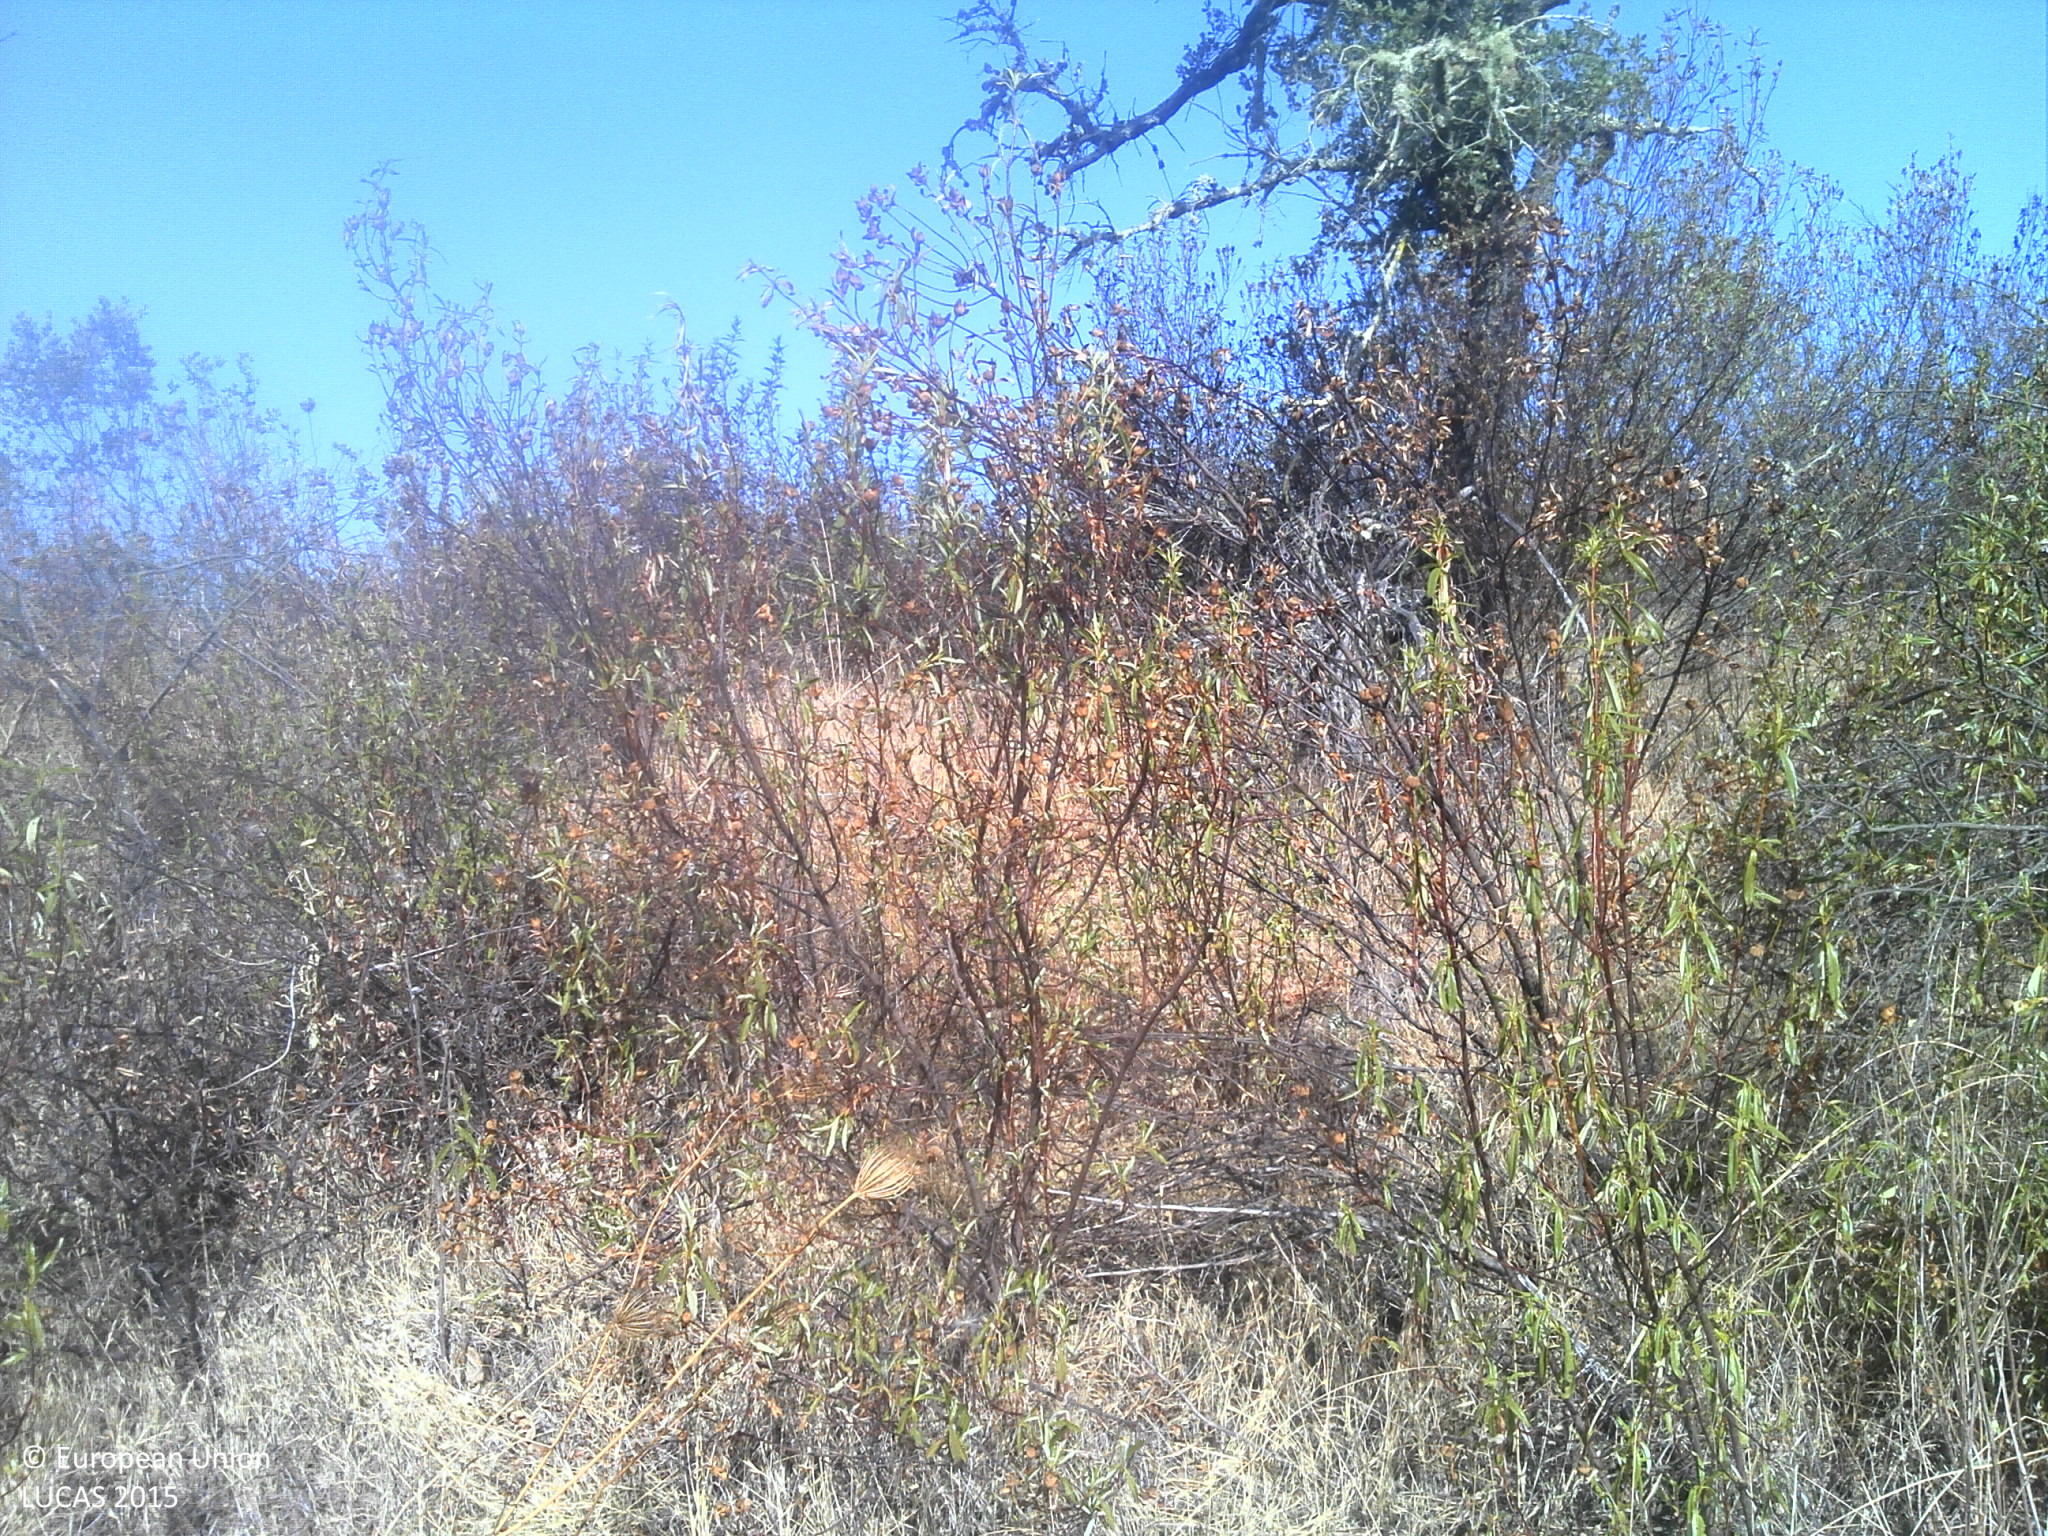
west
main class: Shrubland
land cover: Shrubland with sparse tree cover
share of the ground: 50 - 75 %
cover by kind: shrubs 65 %, herbaceous plants 20 %, unconsolidated bare surface 10 %, broadleaved forest trees 5 %
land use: Forestry
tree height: < 5 m
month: August
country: PT
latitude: 37.5598
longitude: -8.2422
